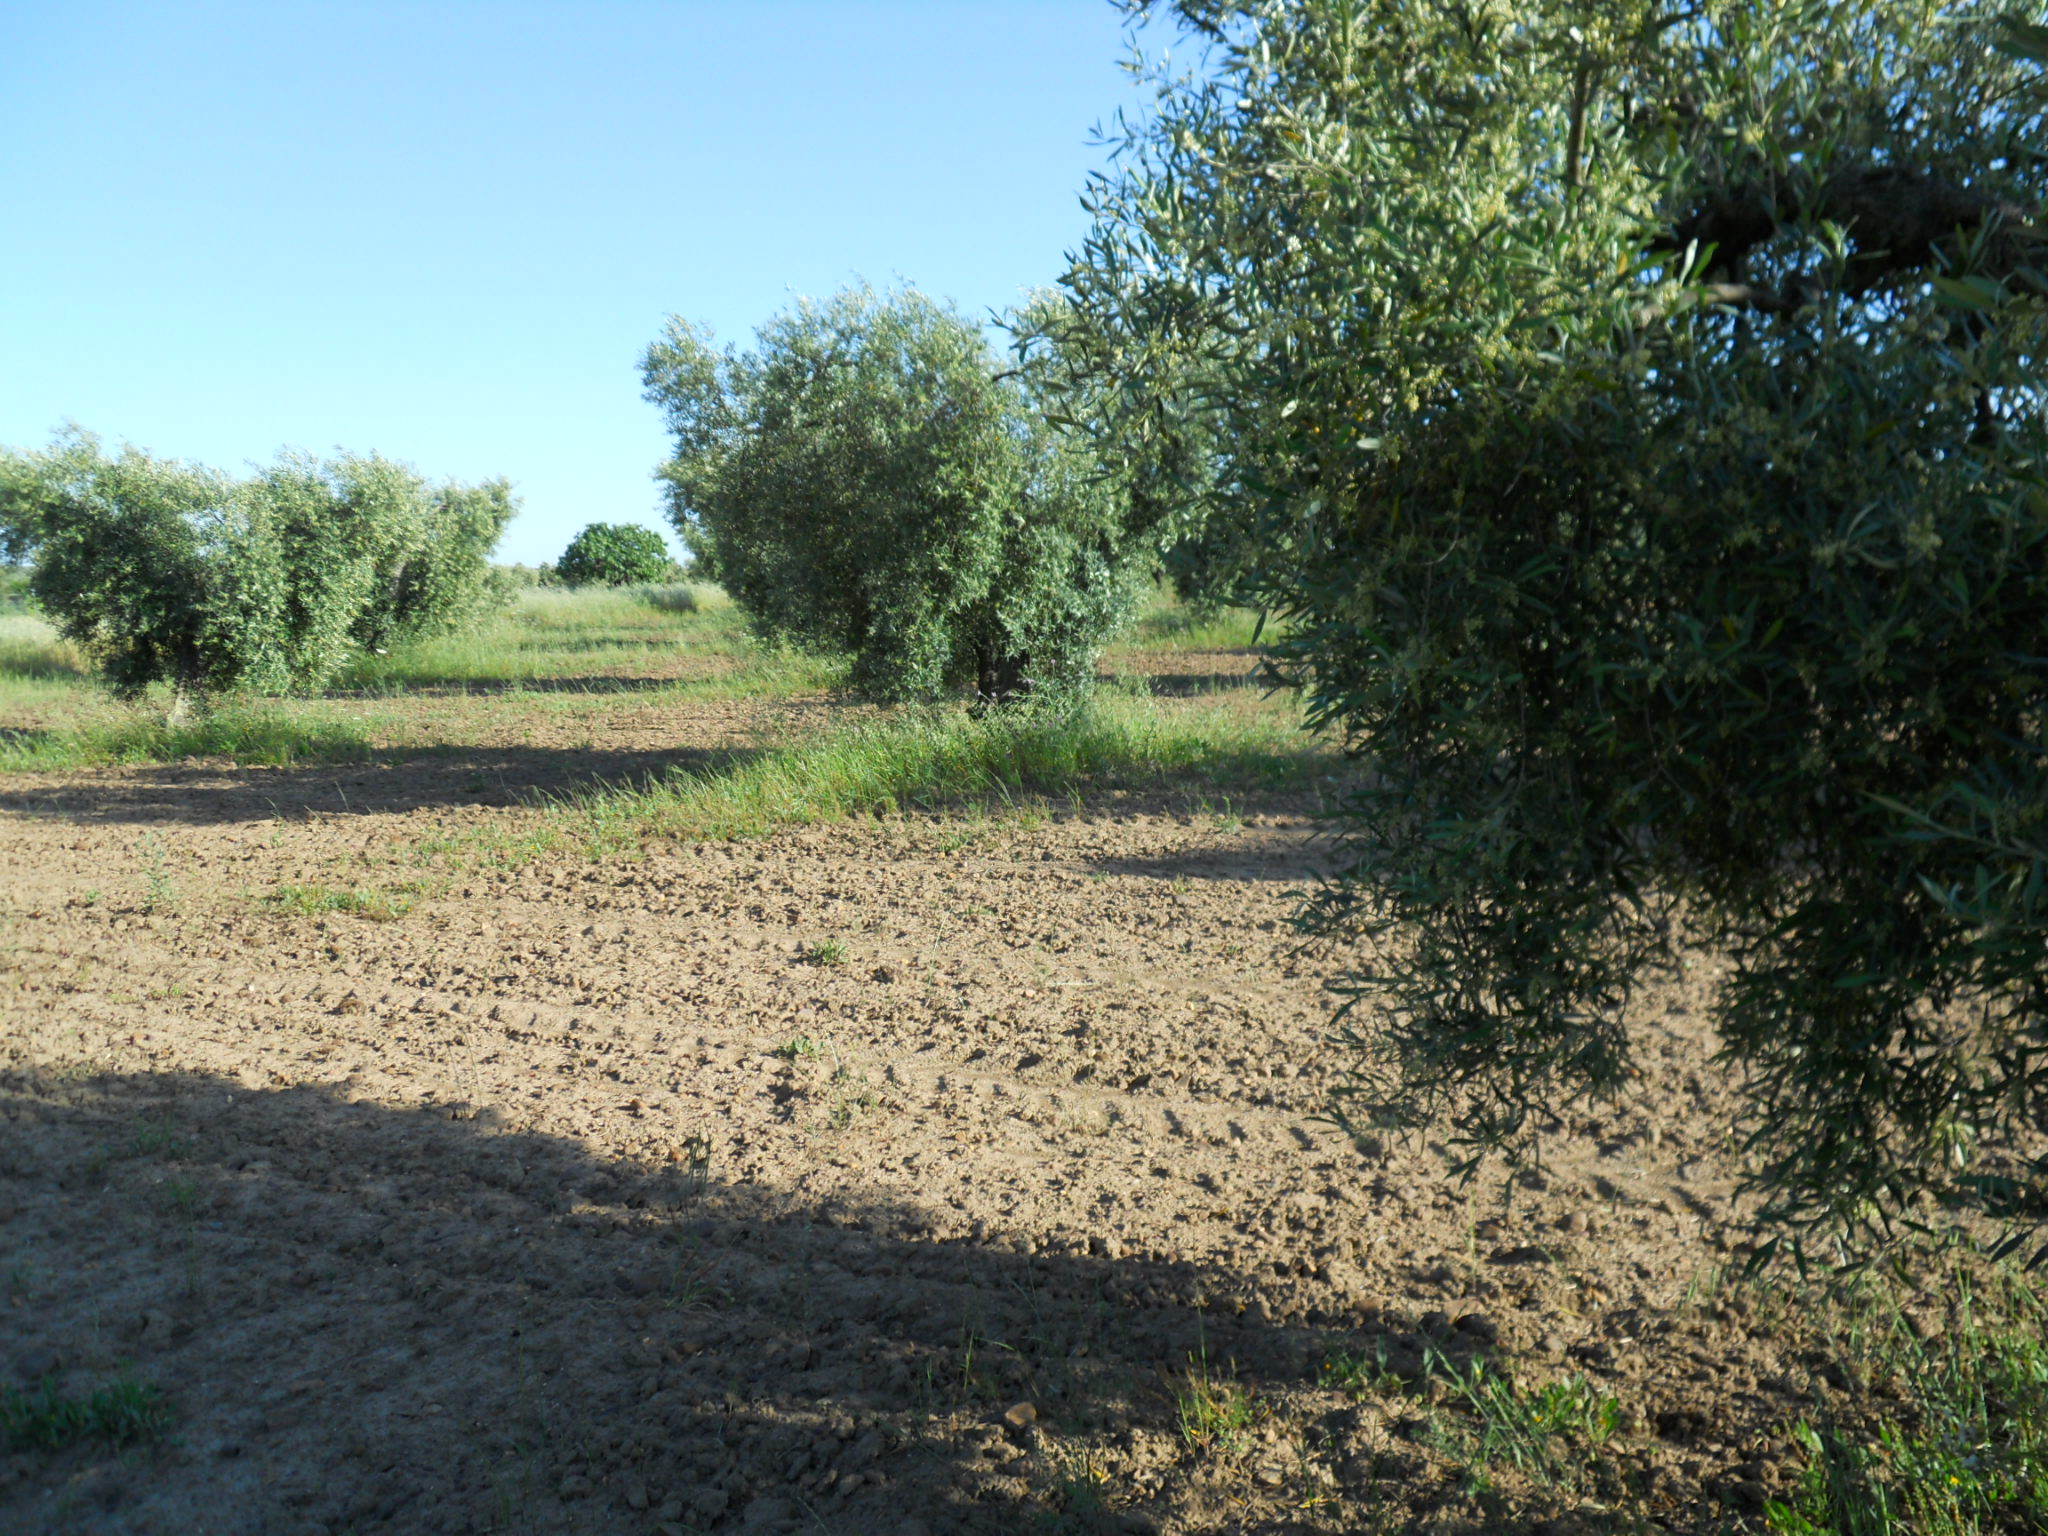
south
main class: Cropland
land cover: Olive groves
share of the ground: > 75 %
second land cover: Spontaneously vegetated surfaces
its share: 10 - 25 %
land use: Agriculture (excluding fallow land and kitchen gardens)
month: May
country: ES
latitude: 38.9783
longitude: -6.5582
